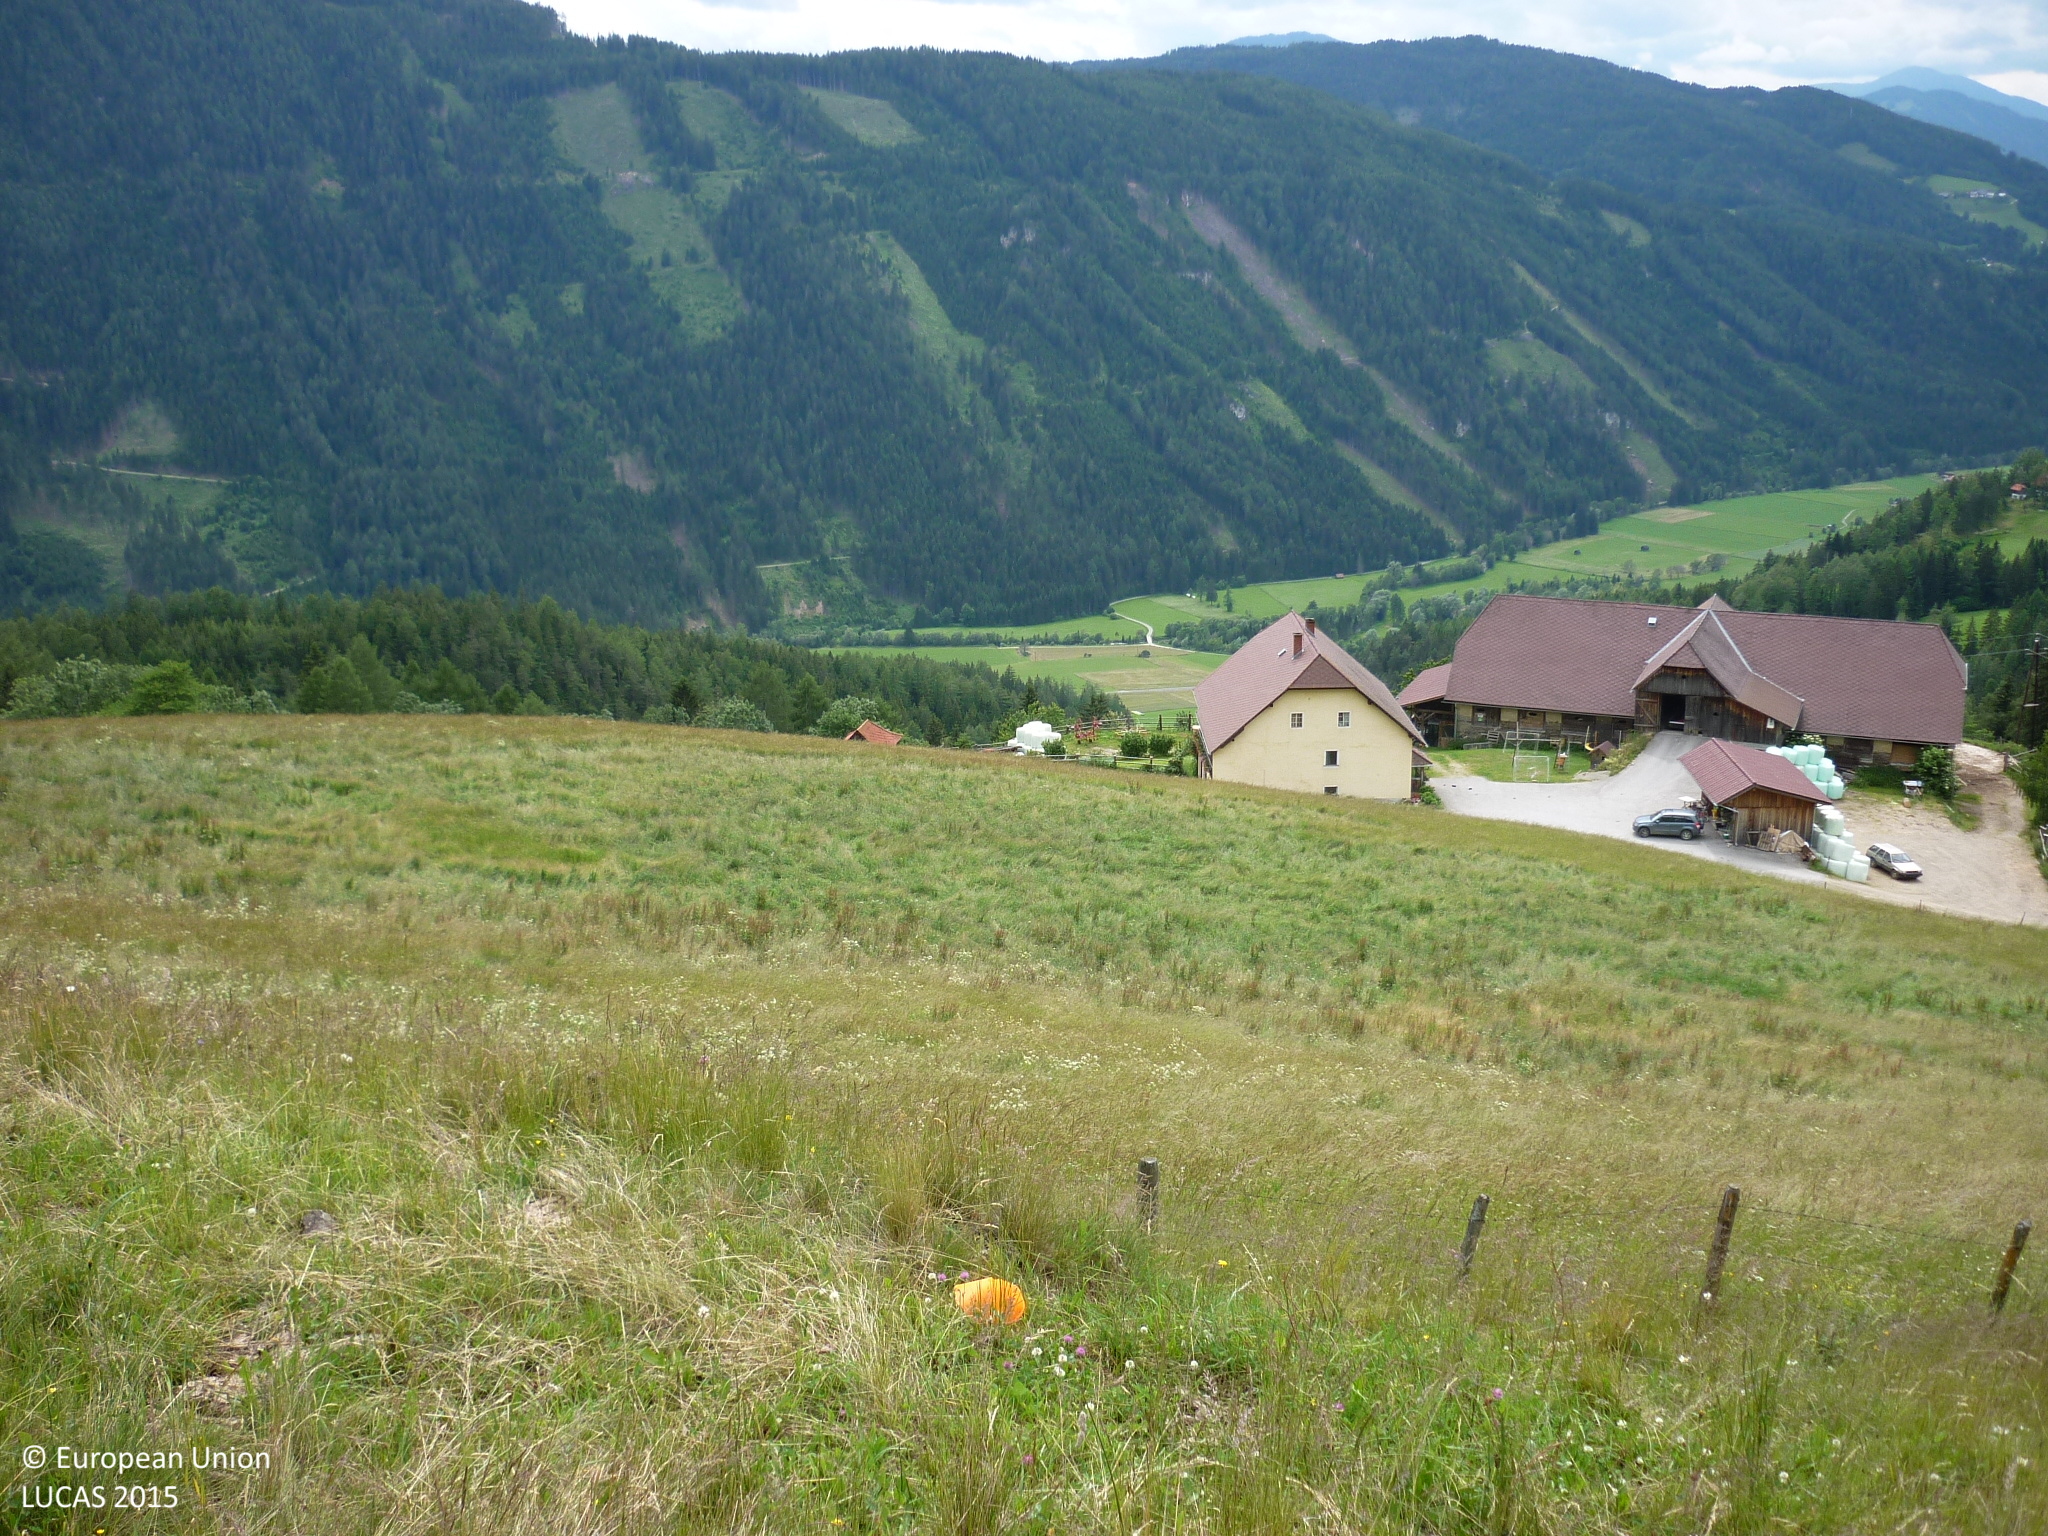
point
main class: Grassland
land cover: Grassland with sparse tree/shrub cover
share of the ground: > 75 %
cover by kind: herbaceous plants 85 %, broadleaved forest trees 5 %, shrubs 5 %, consolidated bare surface 5 %
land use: Agriculture (excluding fallow land and kitchen gardens)
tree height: < 5 m
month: June
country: AT
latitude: 47.2019
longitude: 14.3151
